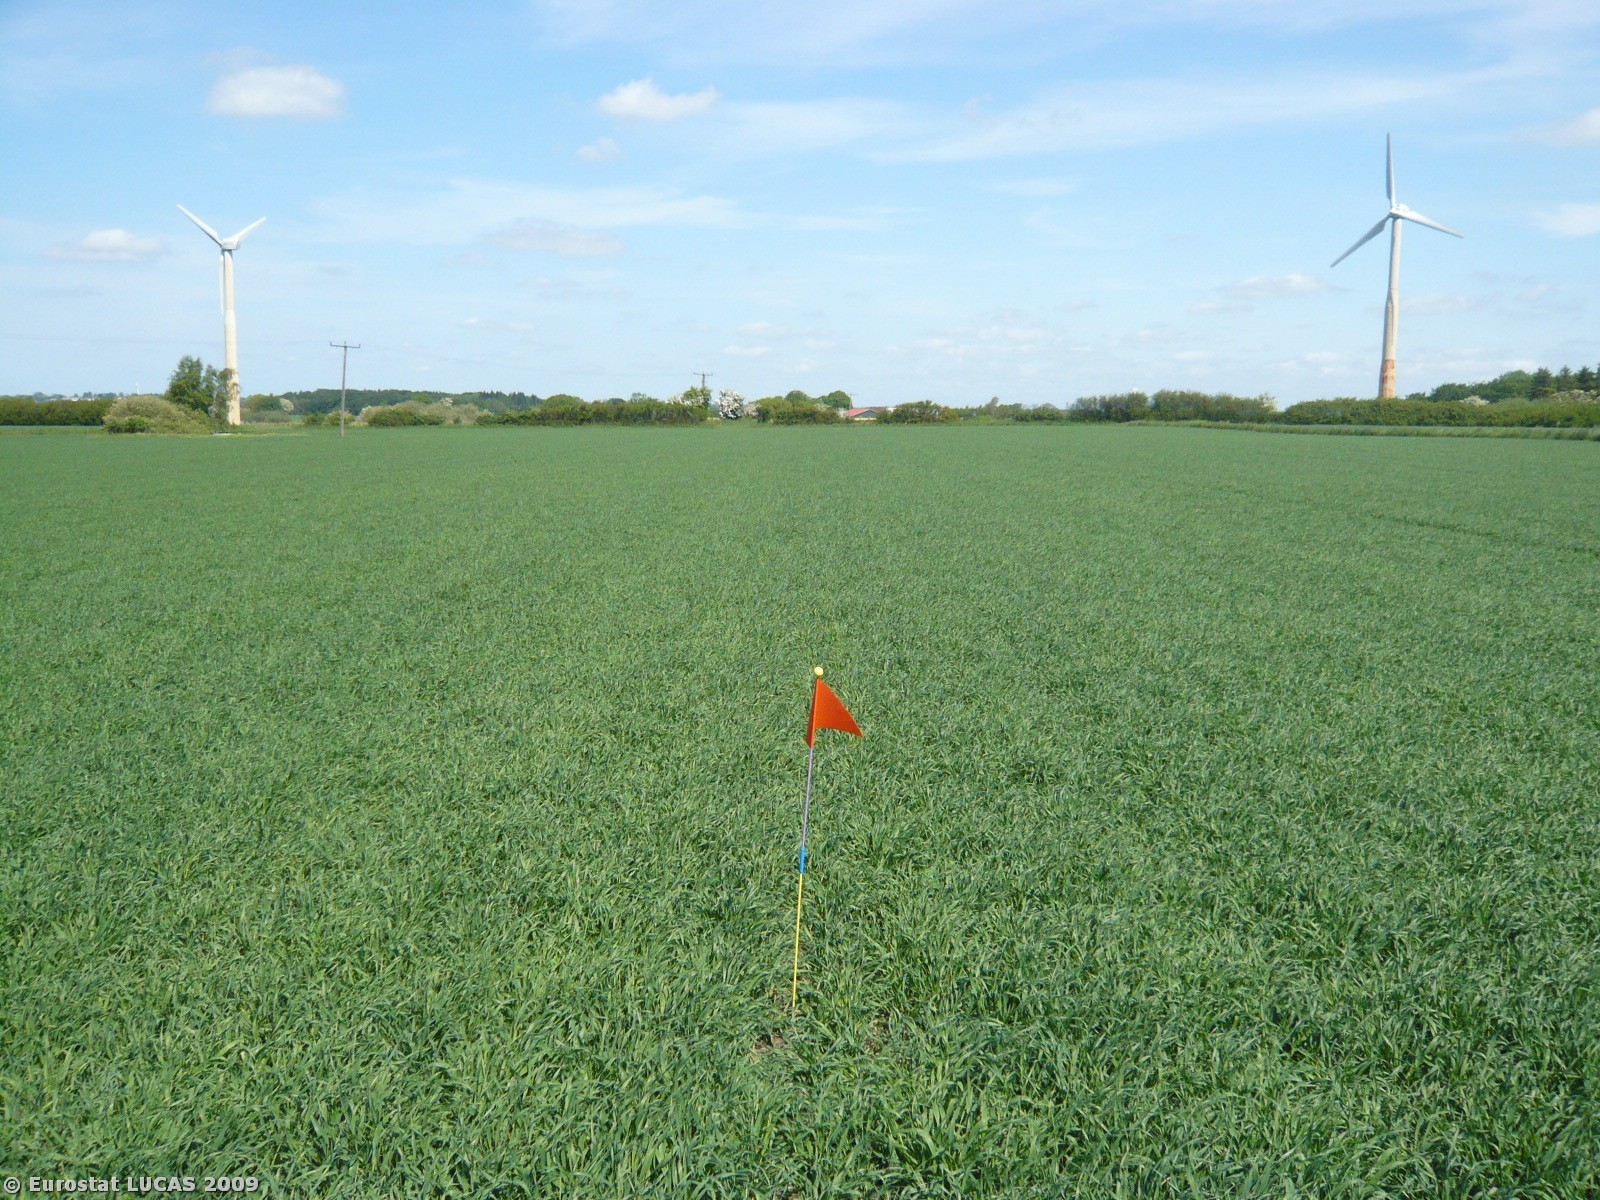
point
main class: Cropland
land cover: Barley
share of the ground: > 75 %
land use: Agriculture (excluding fallow land and kitchen gardens)
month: May
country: DK
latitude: 55.3475
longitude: 11.8436
